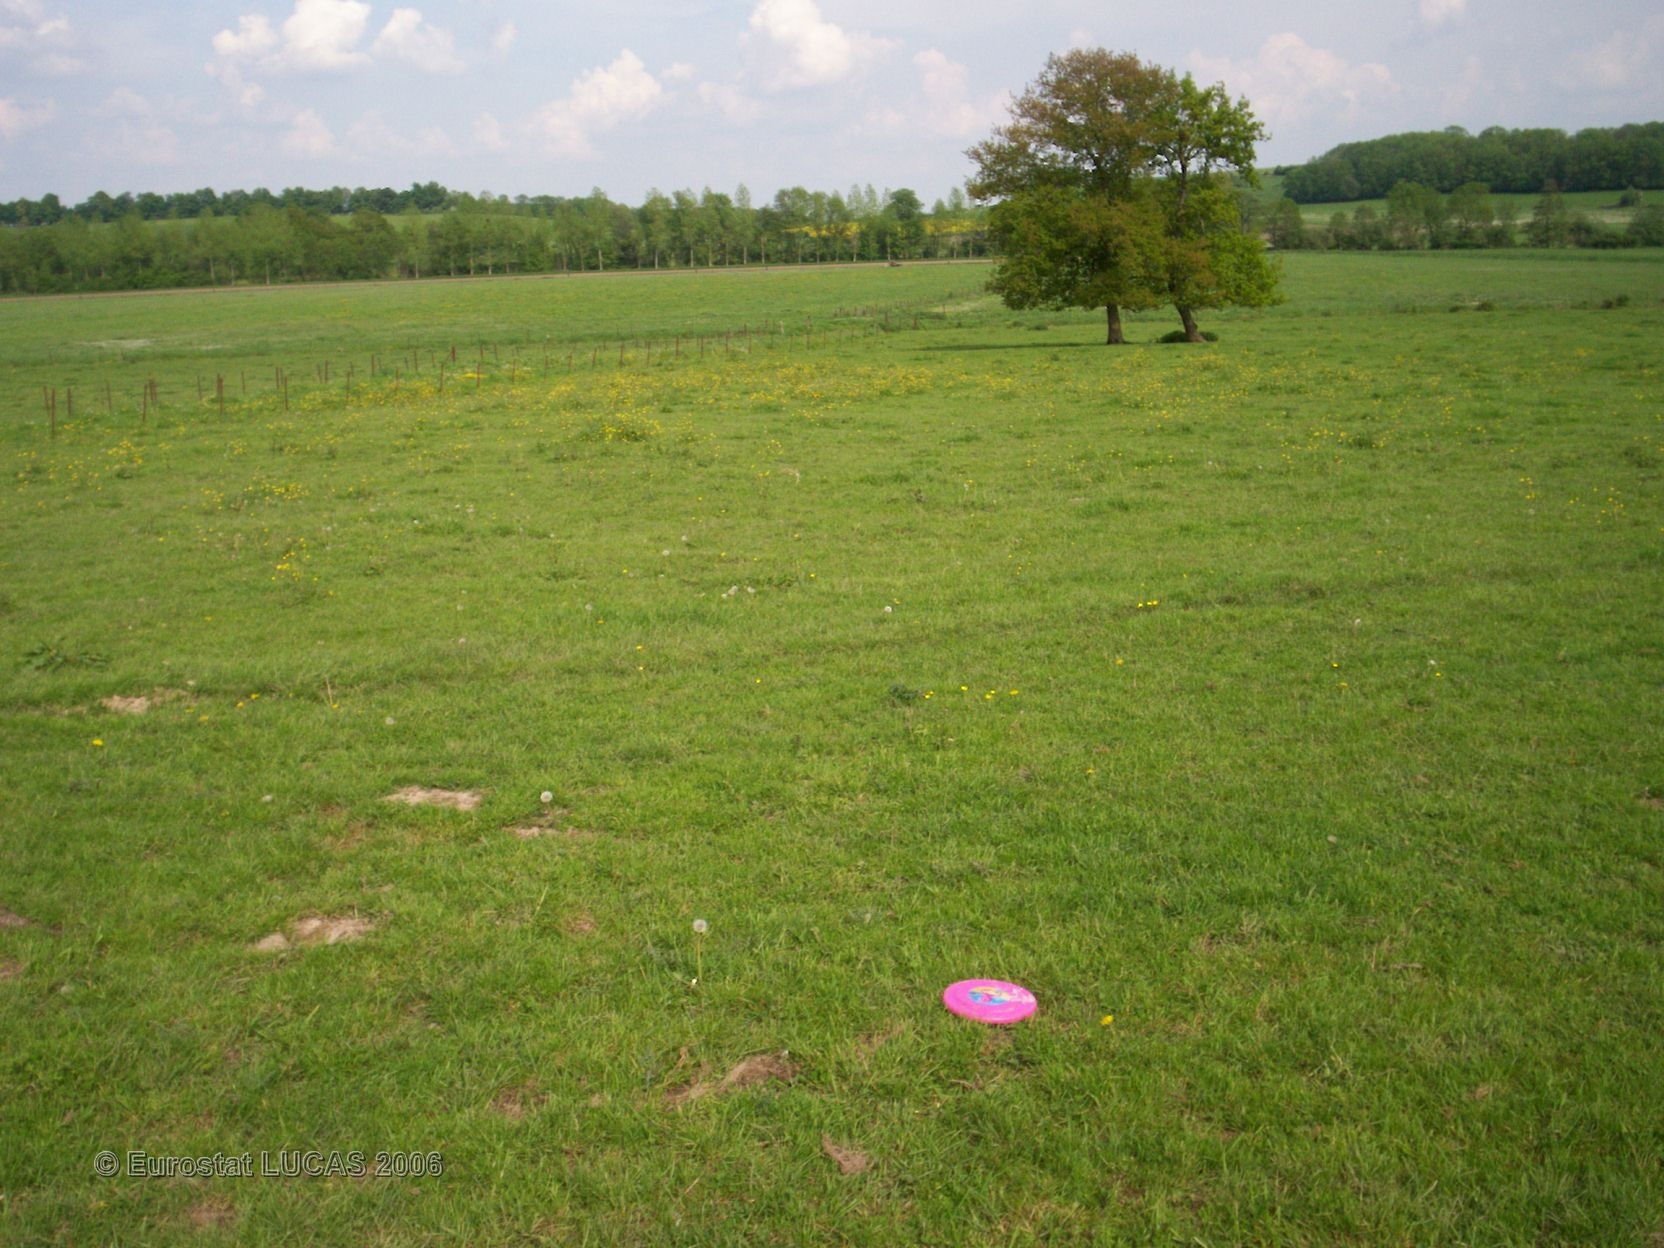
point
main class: Grassland
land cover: Grassland without tree/shrub cover
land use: Agriculture (excluding fallow land and kitchen gardens)
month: May
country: FR
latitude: 49.6273
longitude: 4.3057
